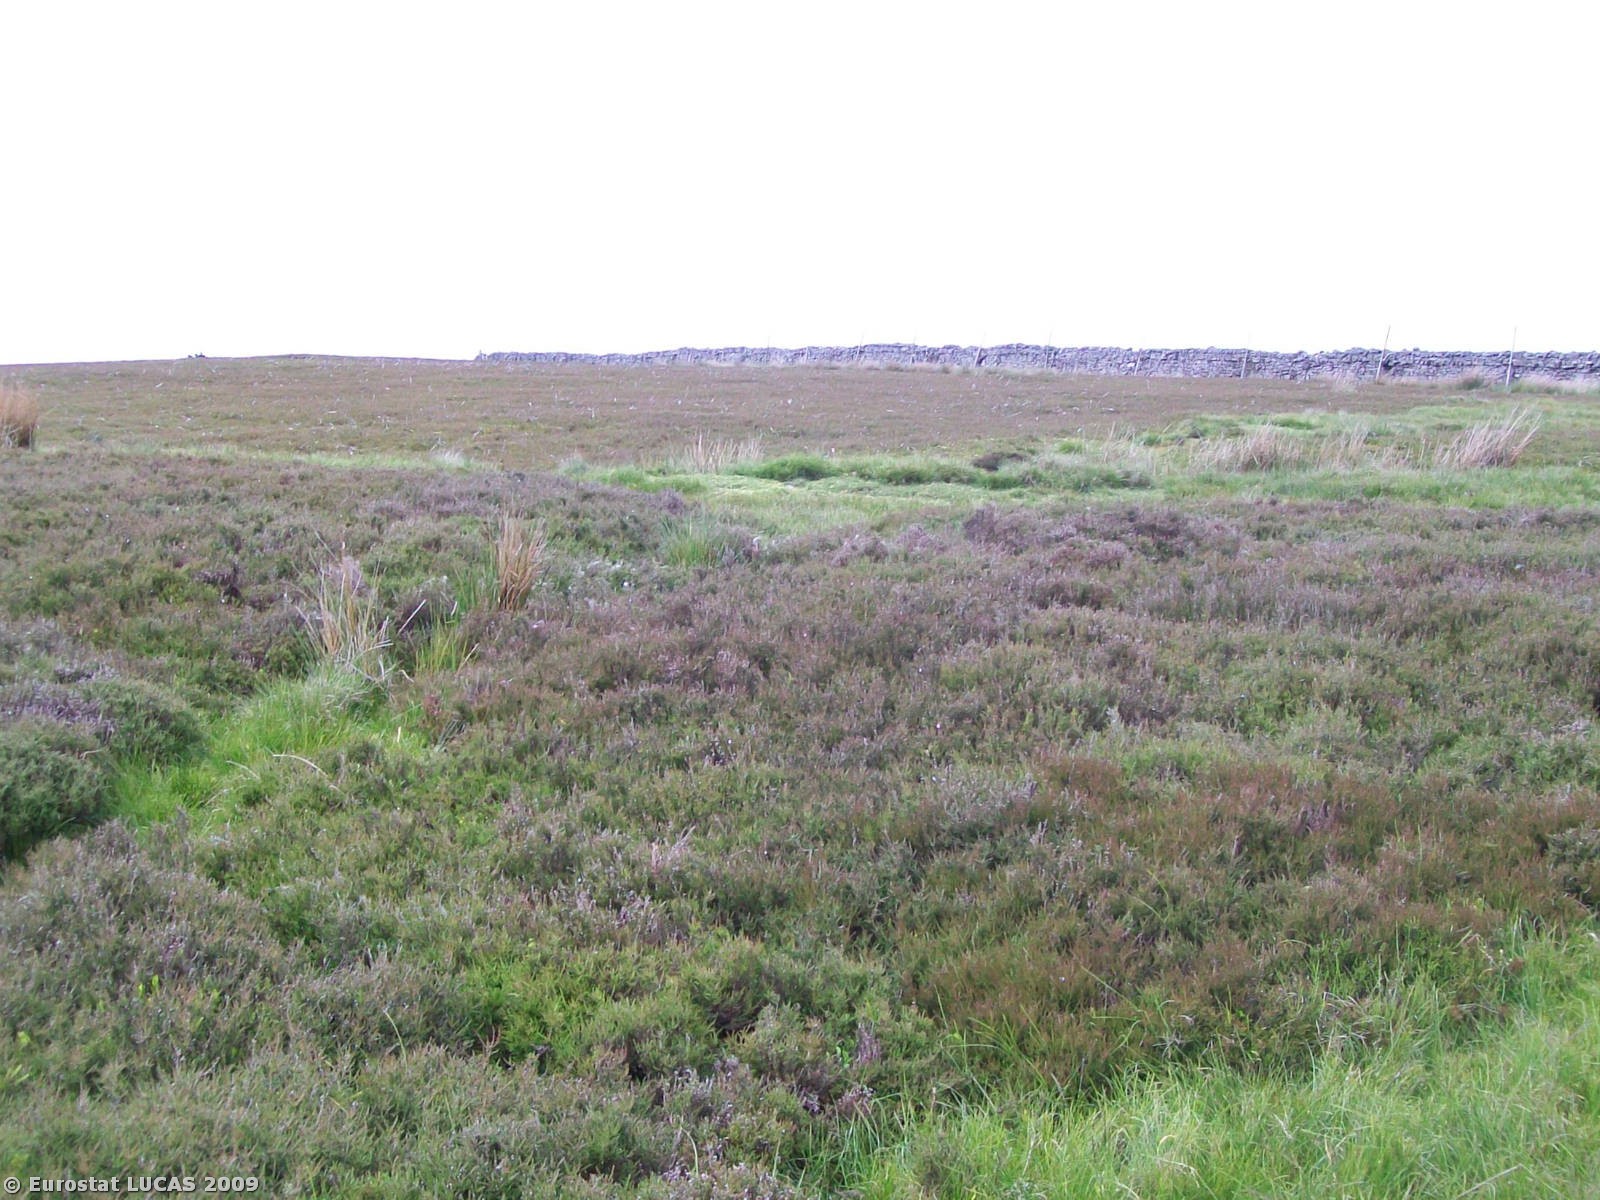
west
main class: Shrubland
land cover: Shrubland without tree cover
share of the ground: 50 - 75 %
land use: Agriculture (excluding fallow land and kitchen gardens)
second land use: Nature reserves
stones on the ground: < 10 %
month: June
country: GB
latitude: 54.4302
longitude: -1.9088
